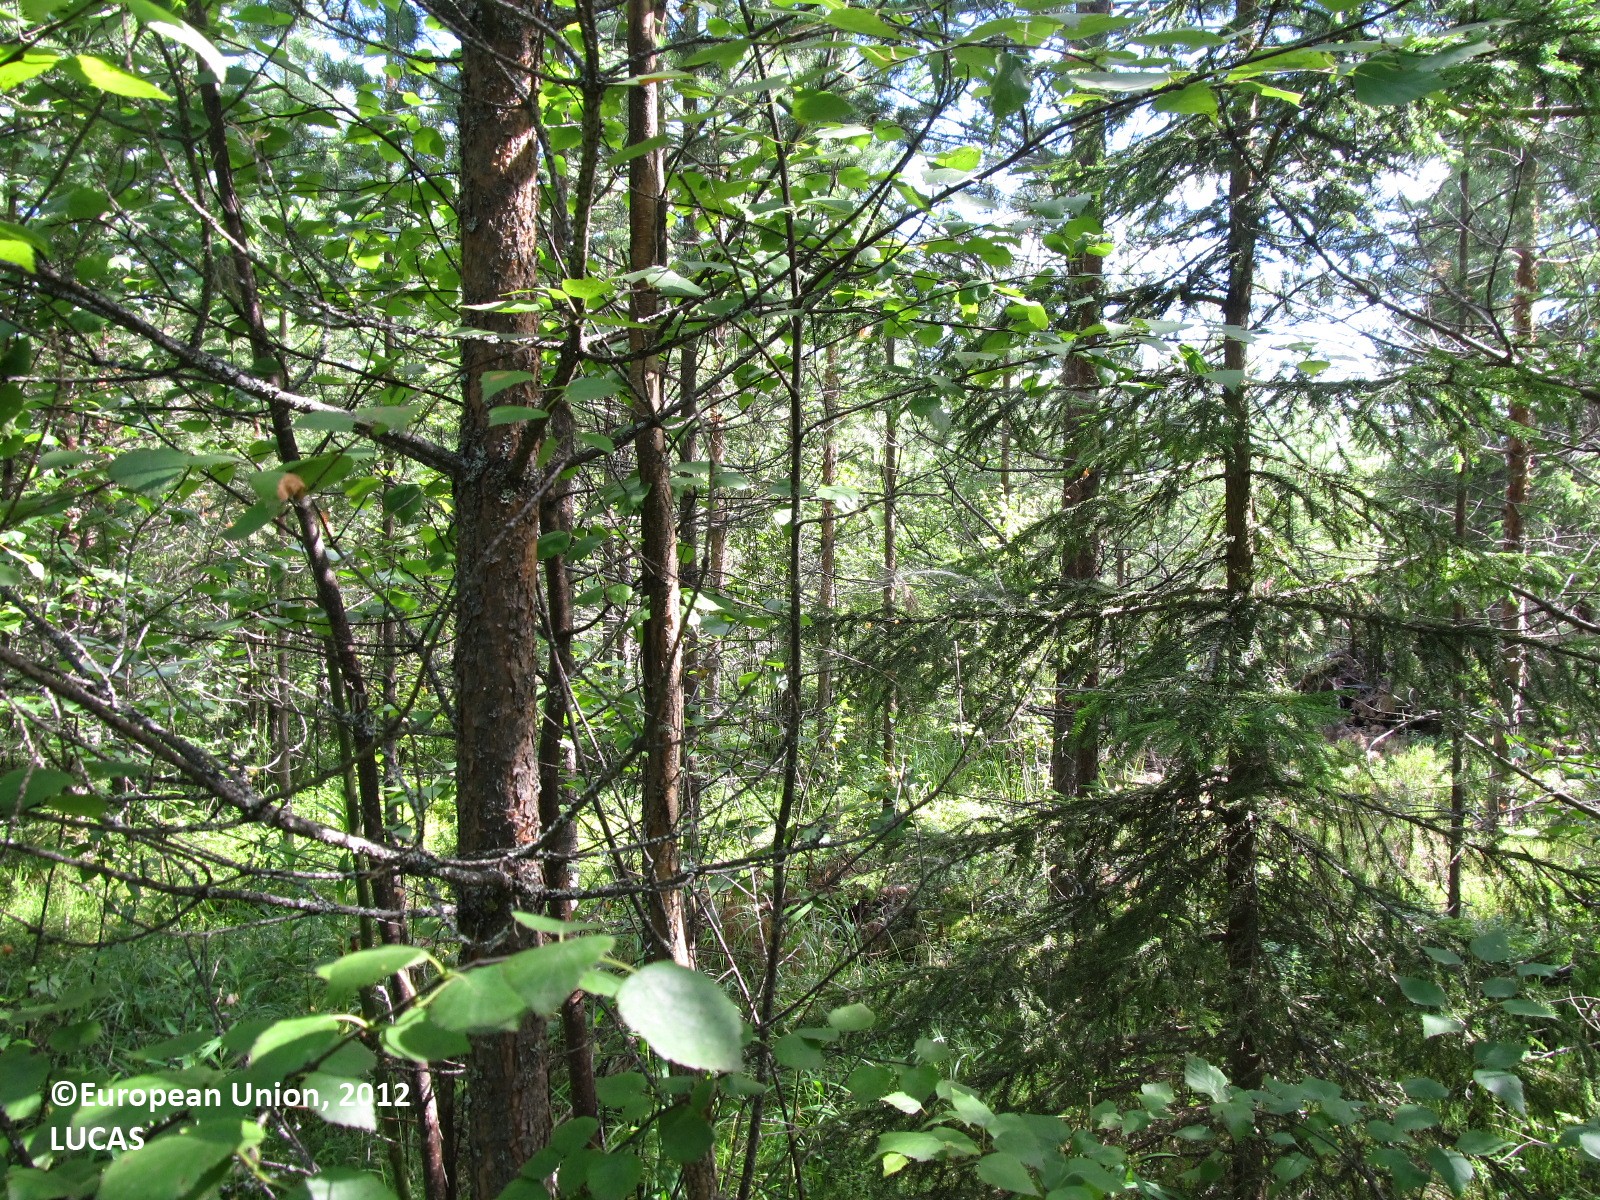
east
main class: Woodland
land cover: Pine dominated mixed woodland
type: boreal forest
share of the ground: 50 - 75 %
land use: Forestry
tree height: > 5 m
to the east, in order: Pine dominated mixed woodland; Pine dominated coniferous woodland
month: July
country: FI
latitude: 62.0221
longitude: 27.9377
